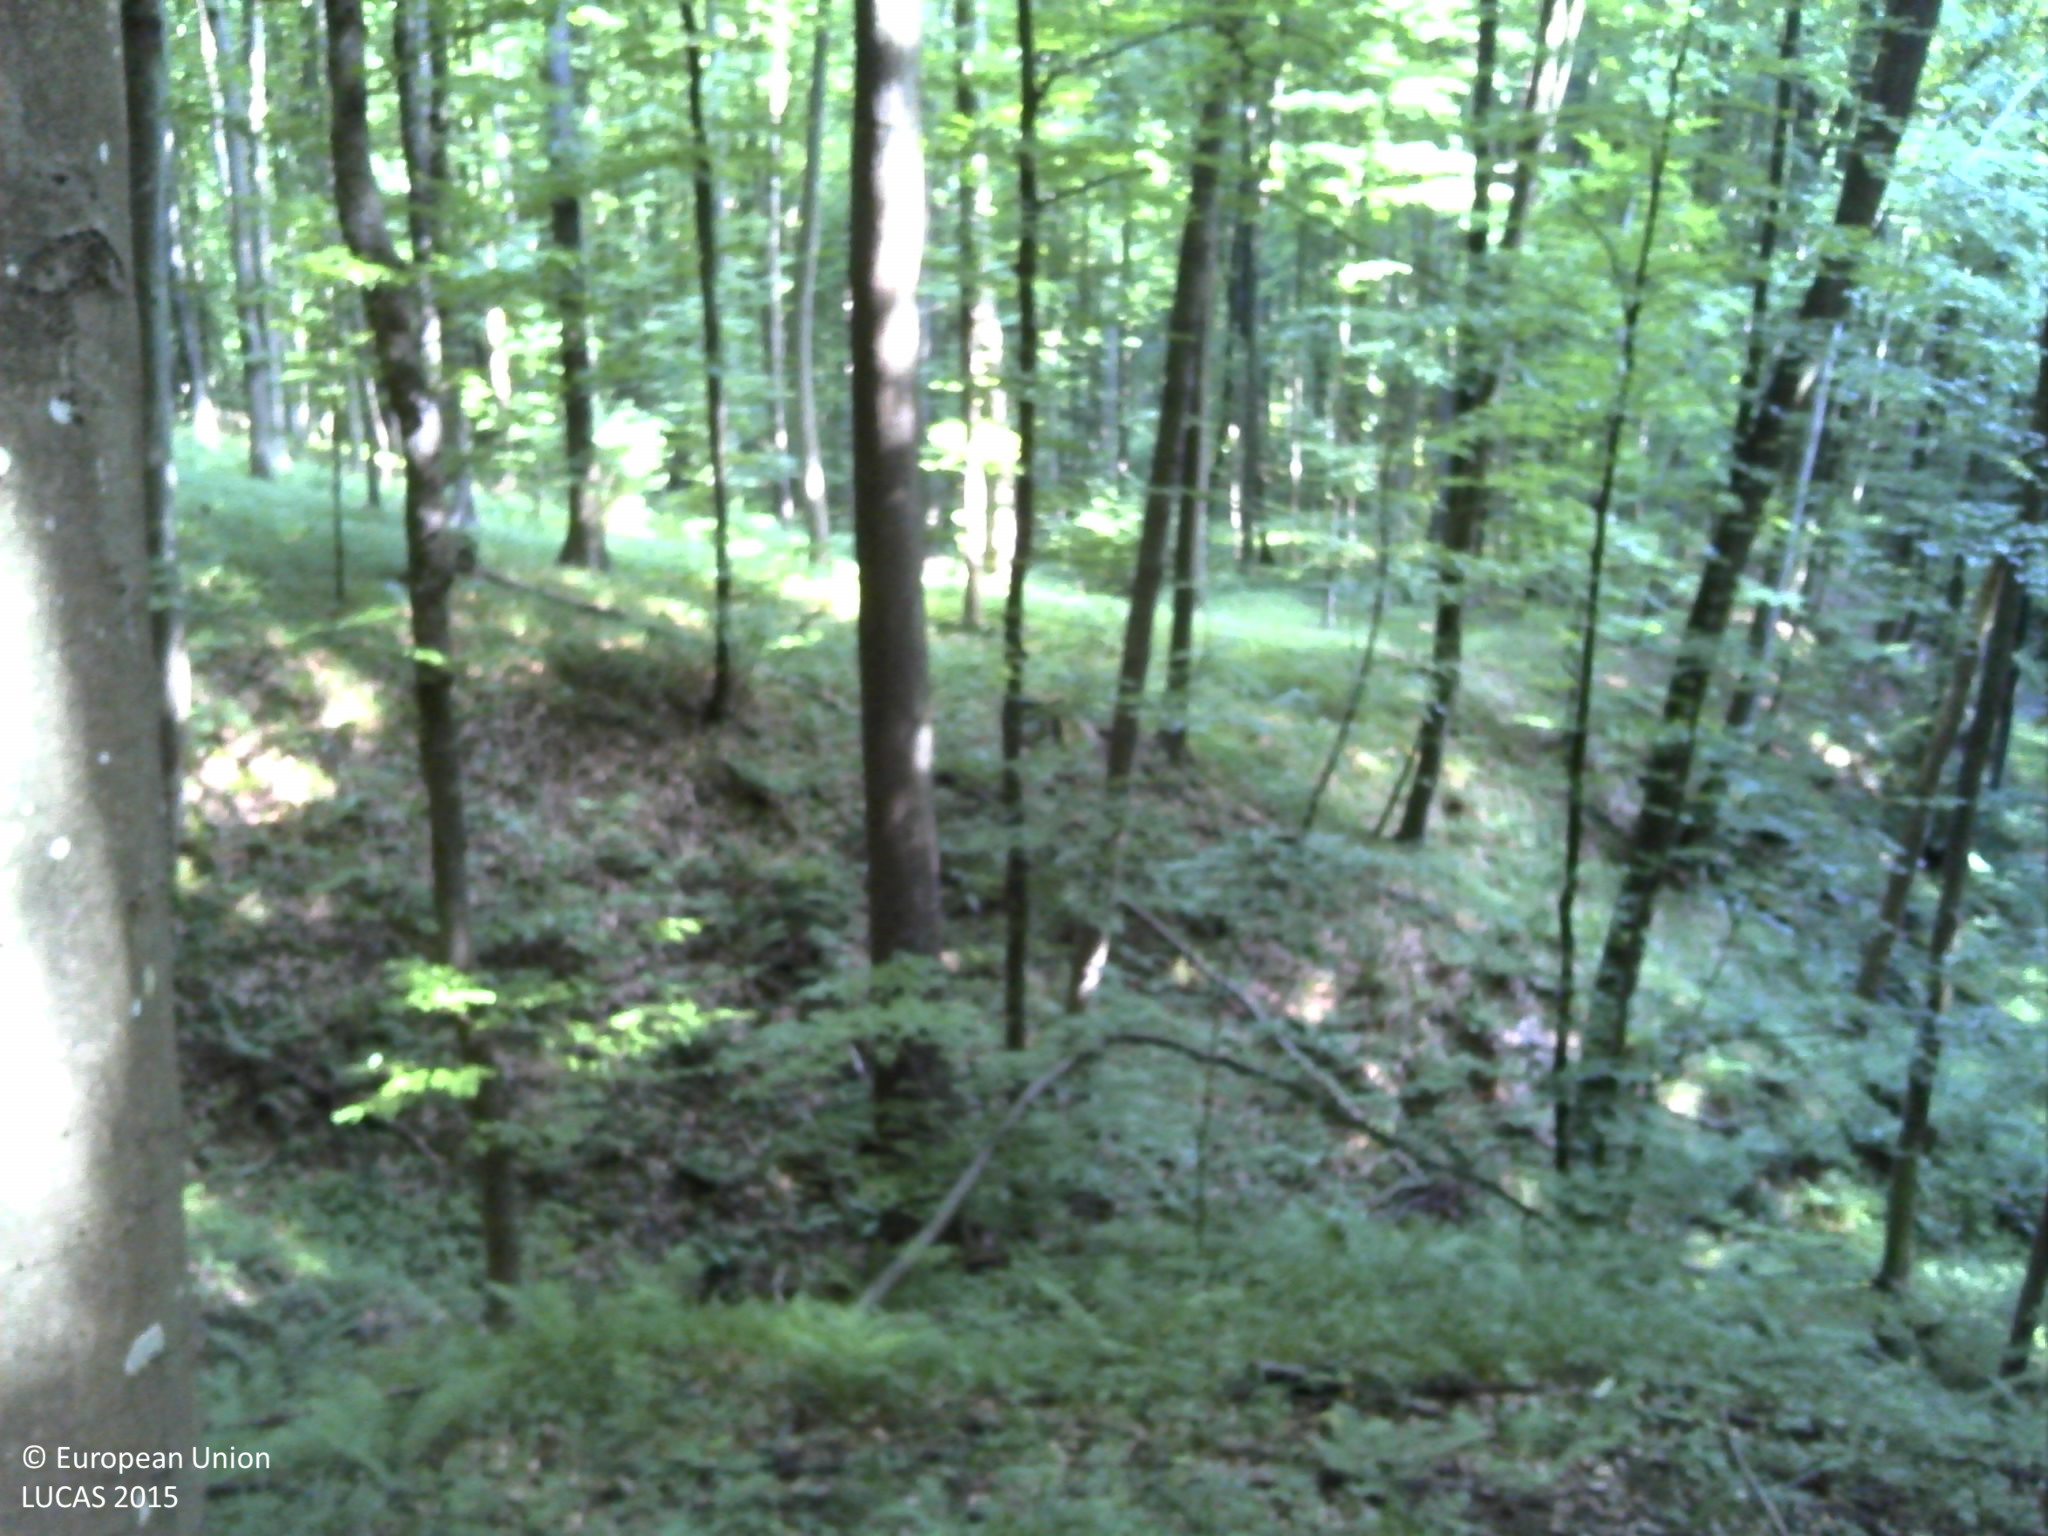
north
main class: Woodland
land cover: Broadleaved woodland
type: beech forest
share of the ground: > 75 %
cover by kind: broadleaved forest trees 100 %
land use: Forestry
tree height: > 5 m
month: June
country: HR
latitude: 45.8355
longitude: 17.2241
